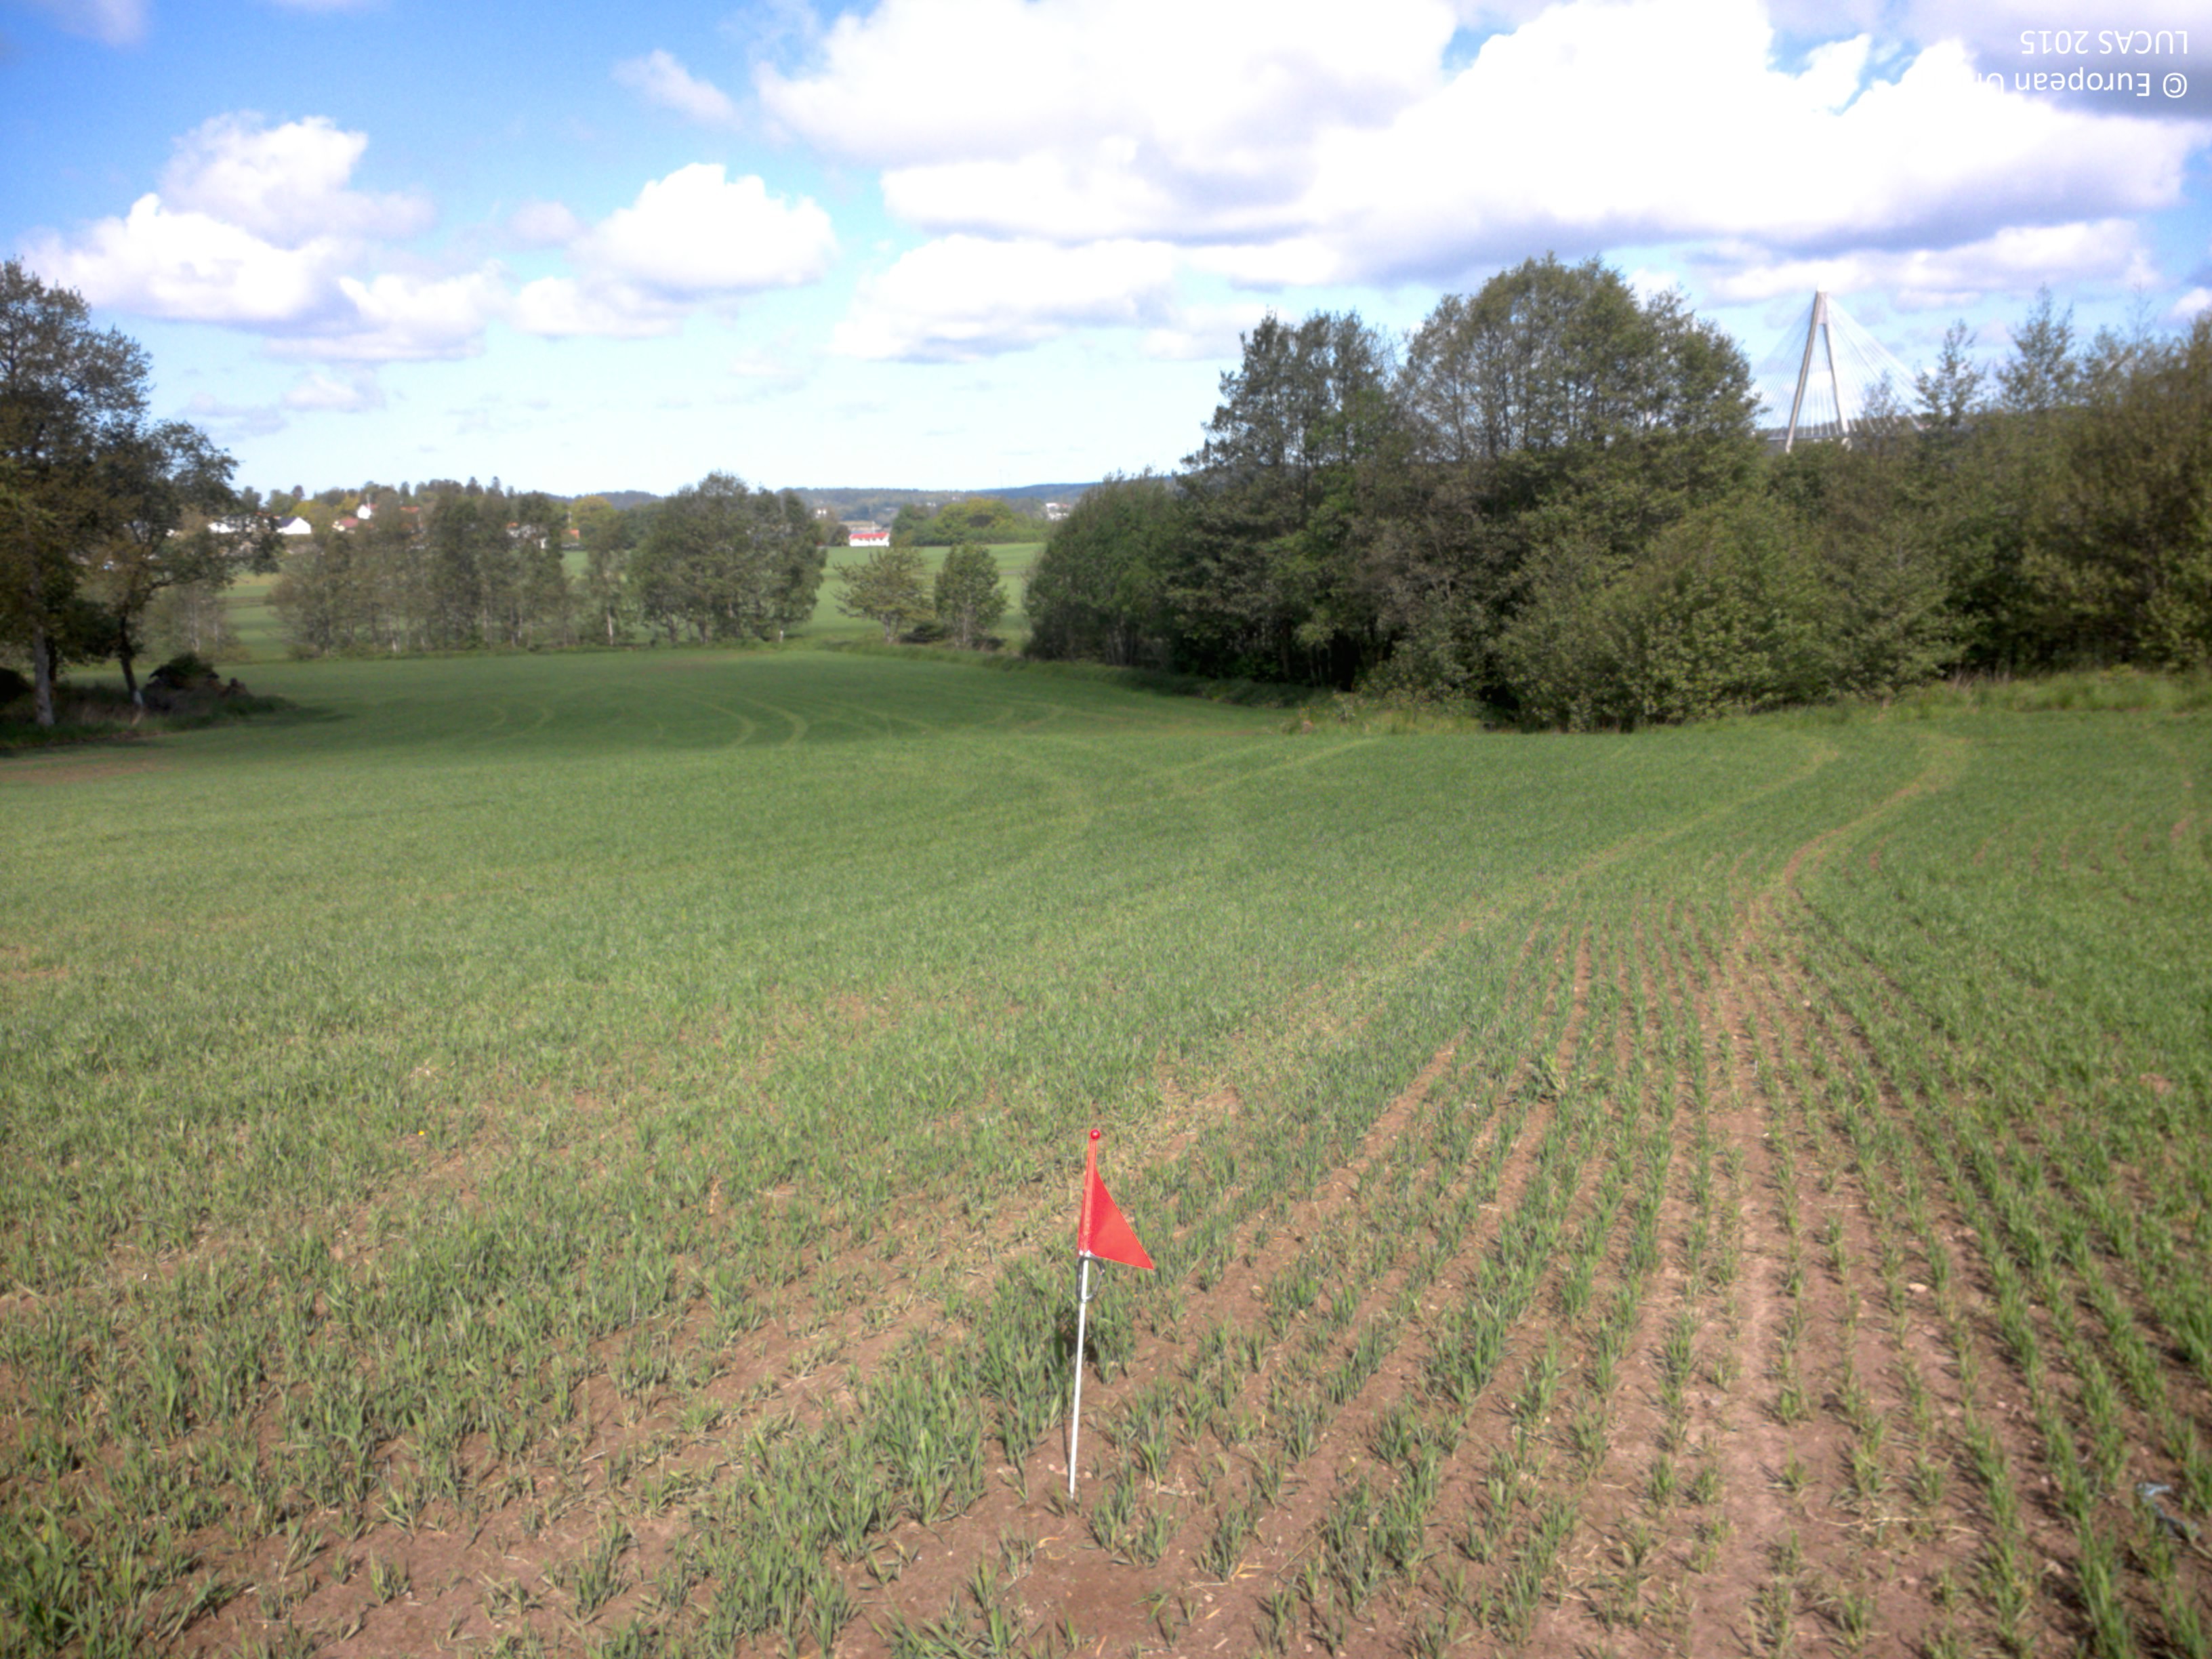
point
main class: Cropland
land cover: Common wheat
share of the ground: 50 - 75 %
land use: Agriculture (excluding fallow land and kitchen gardens)
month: June
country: SE
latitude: 58.3146
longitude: 11.8568
